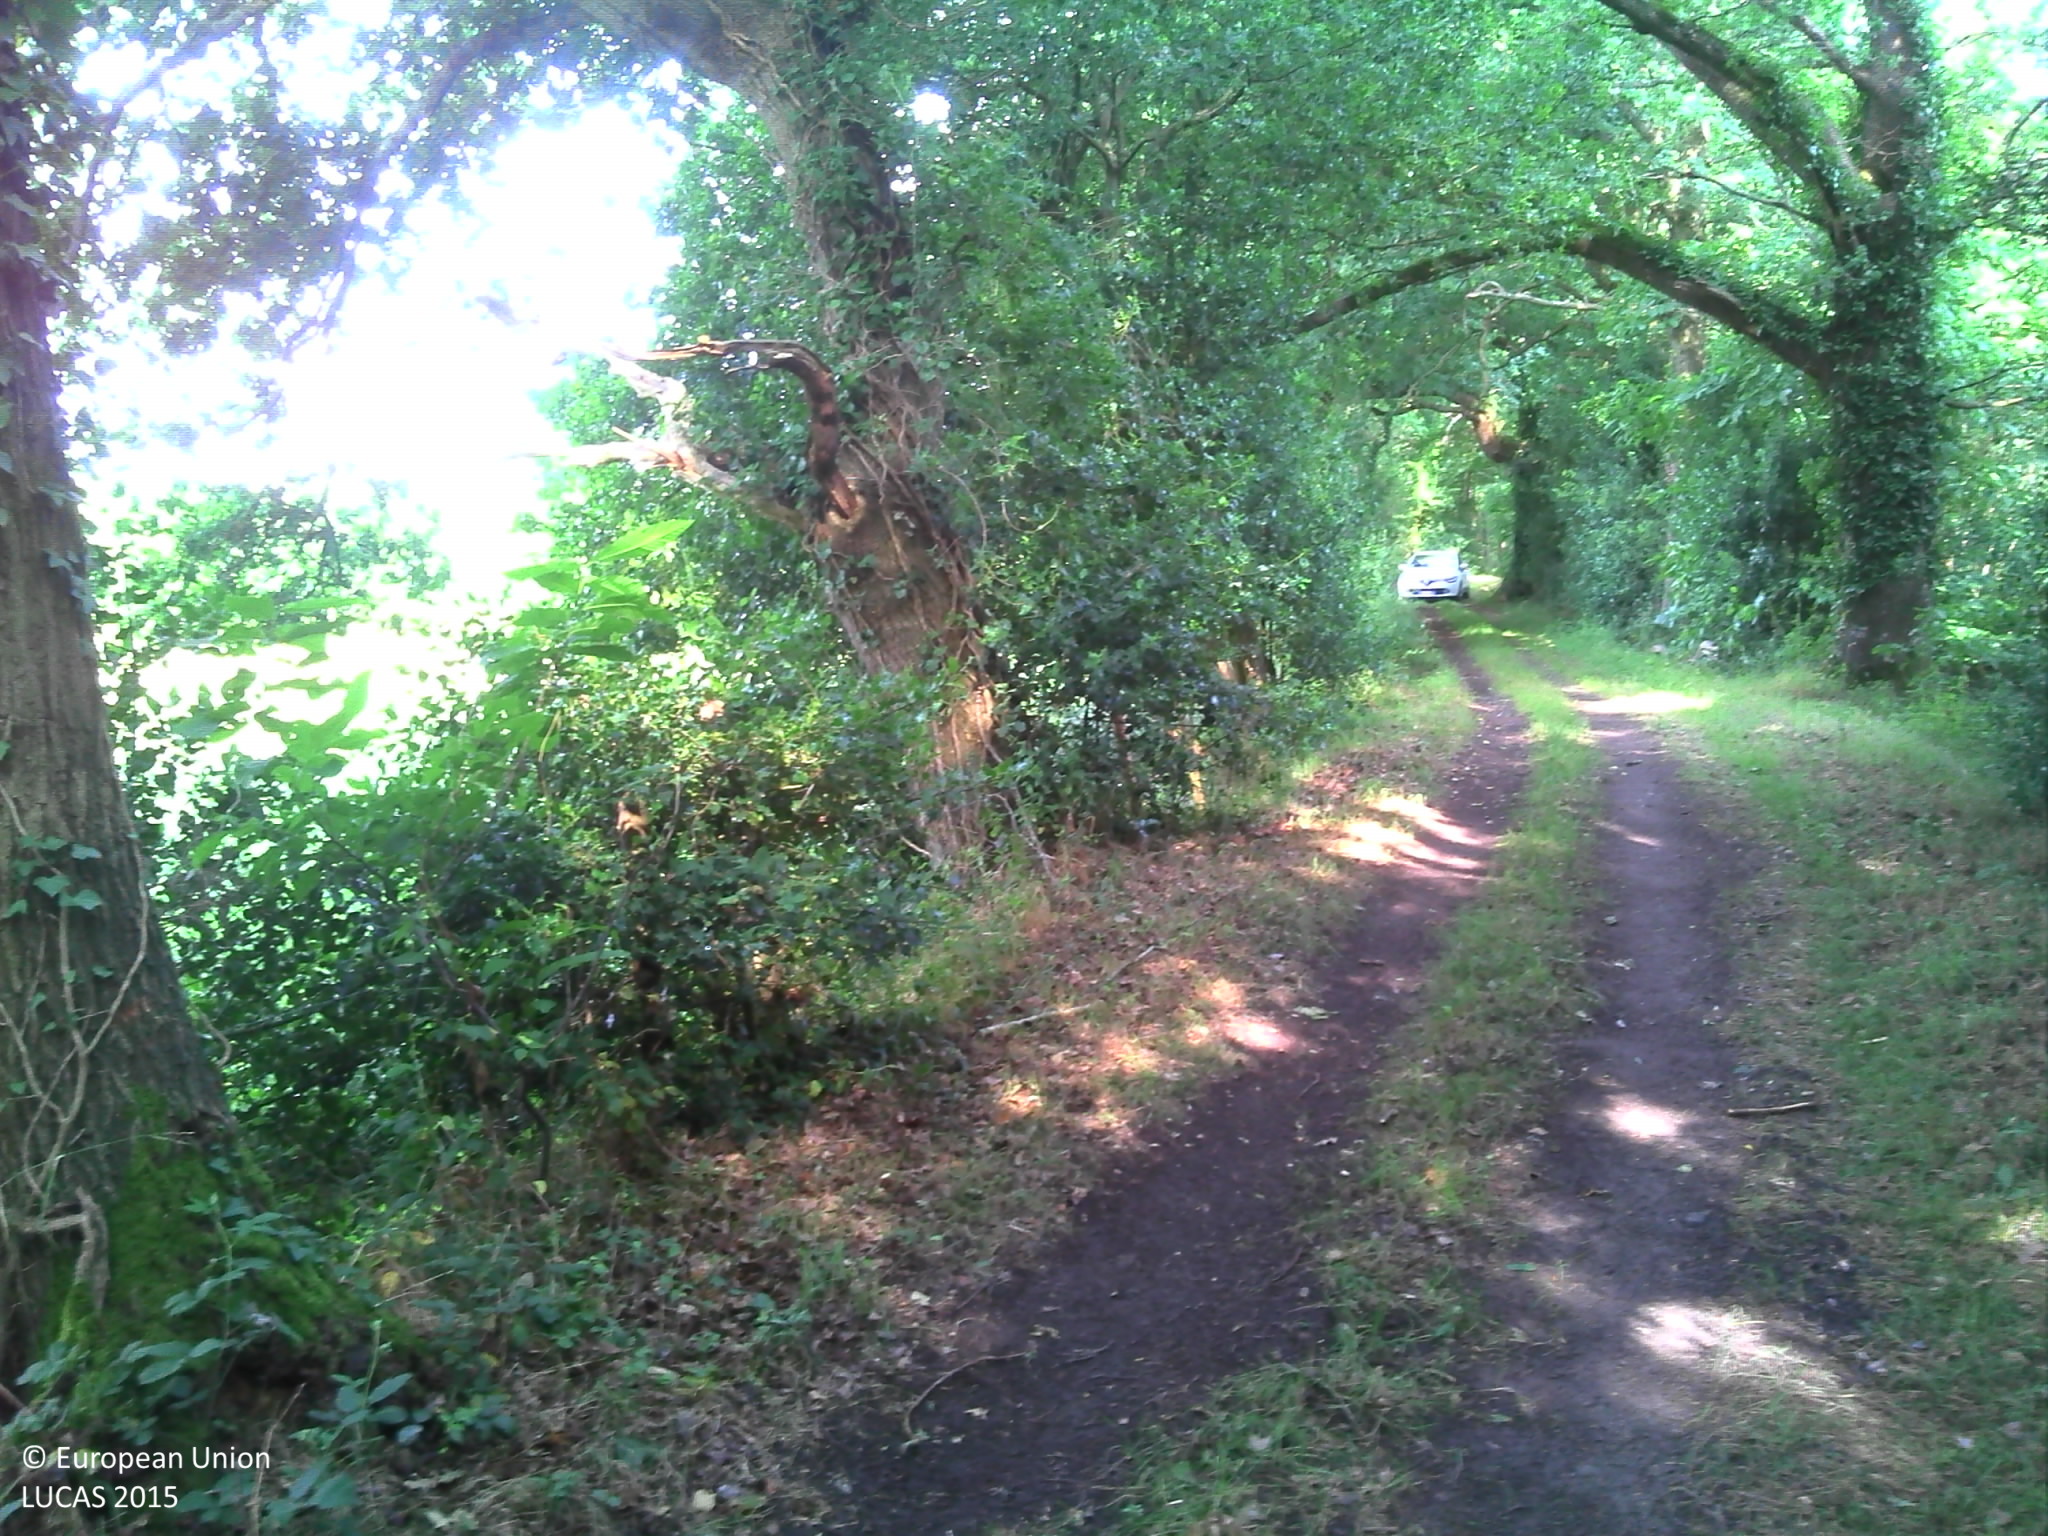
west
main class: Artificial land
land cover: Non built-up linear features
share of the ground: > 75 %
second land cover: Grassland without tree/shrub cover
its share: > 75 %
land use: Road transport
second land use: Agriculture (excluding fallow land and kitchen gardens)
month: July
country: FR
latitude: 47.3229
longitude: -1.8888
